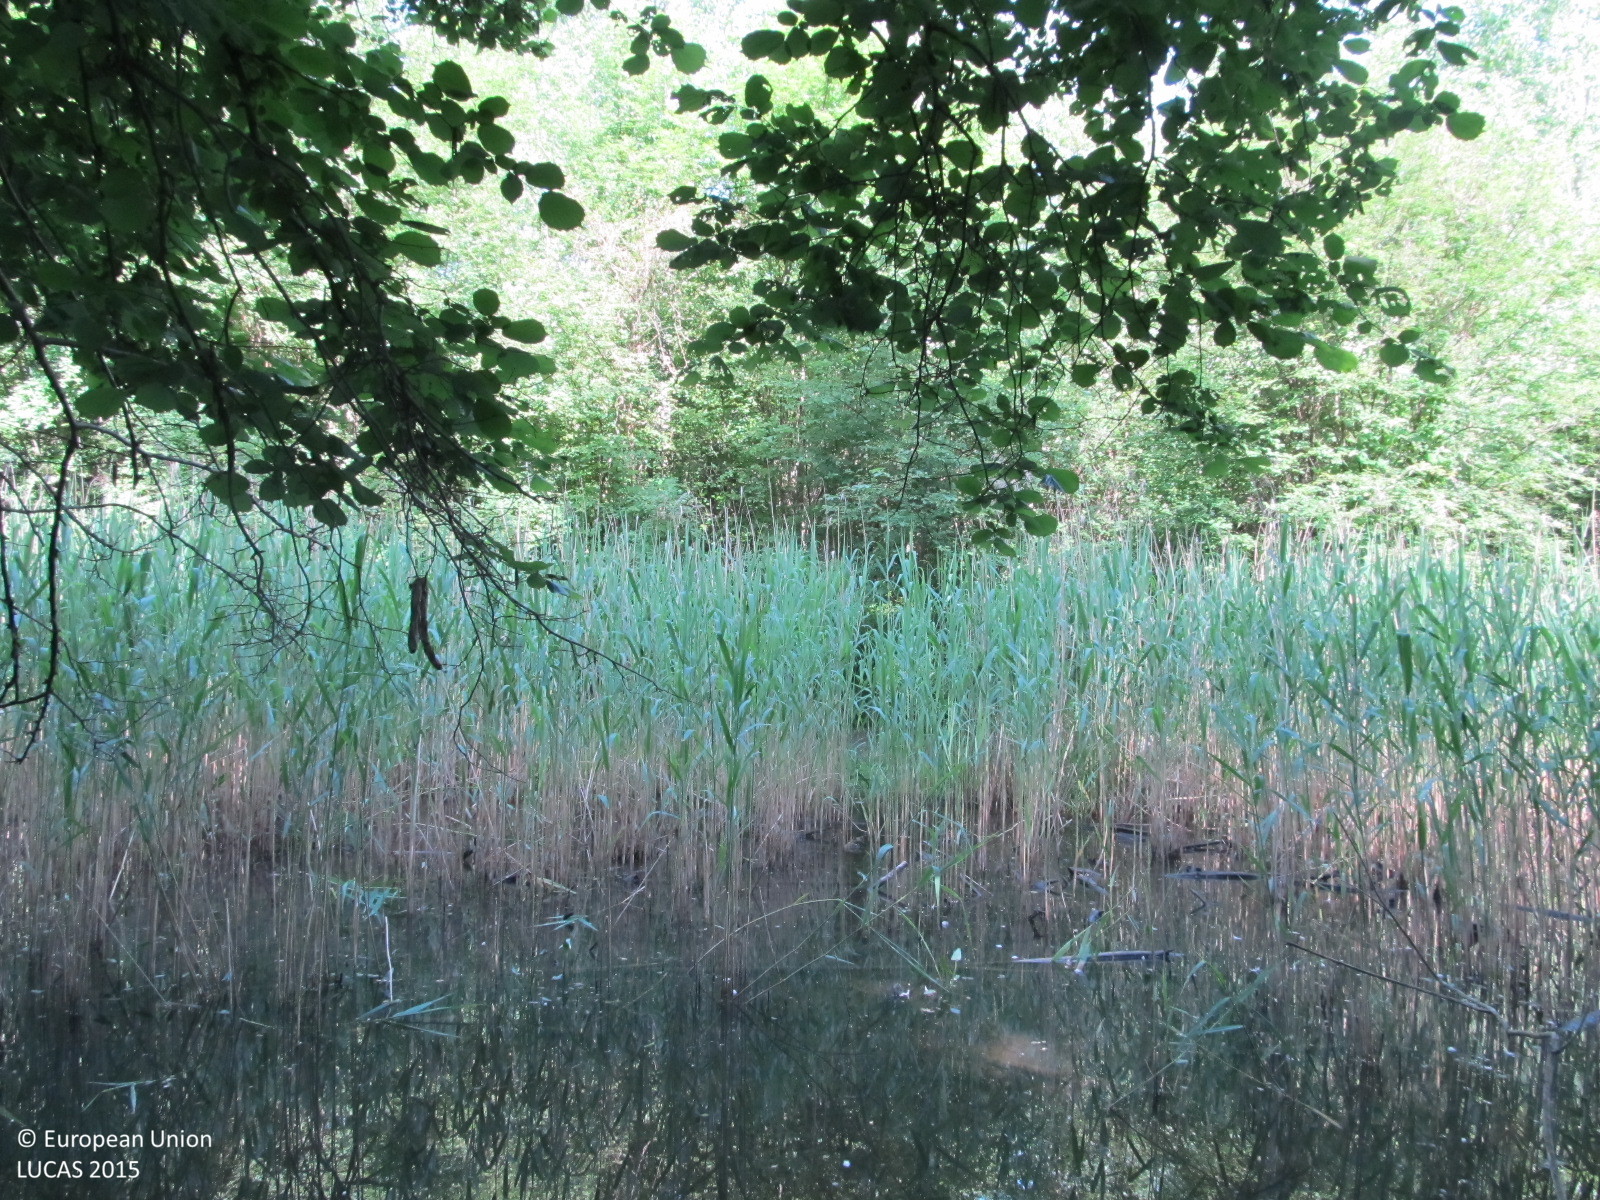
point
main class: Woodland
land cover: Broadleaved woodland
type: floodplain forest
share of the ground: 50 - 75 %
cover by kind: broadleaved forest trees 70 %, shrubs 20 %, herbaceous plants 10 %
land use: Forestry
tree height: > 5 m
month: May
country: AT
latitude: 48.3957
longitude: 15.7975
